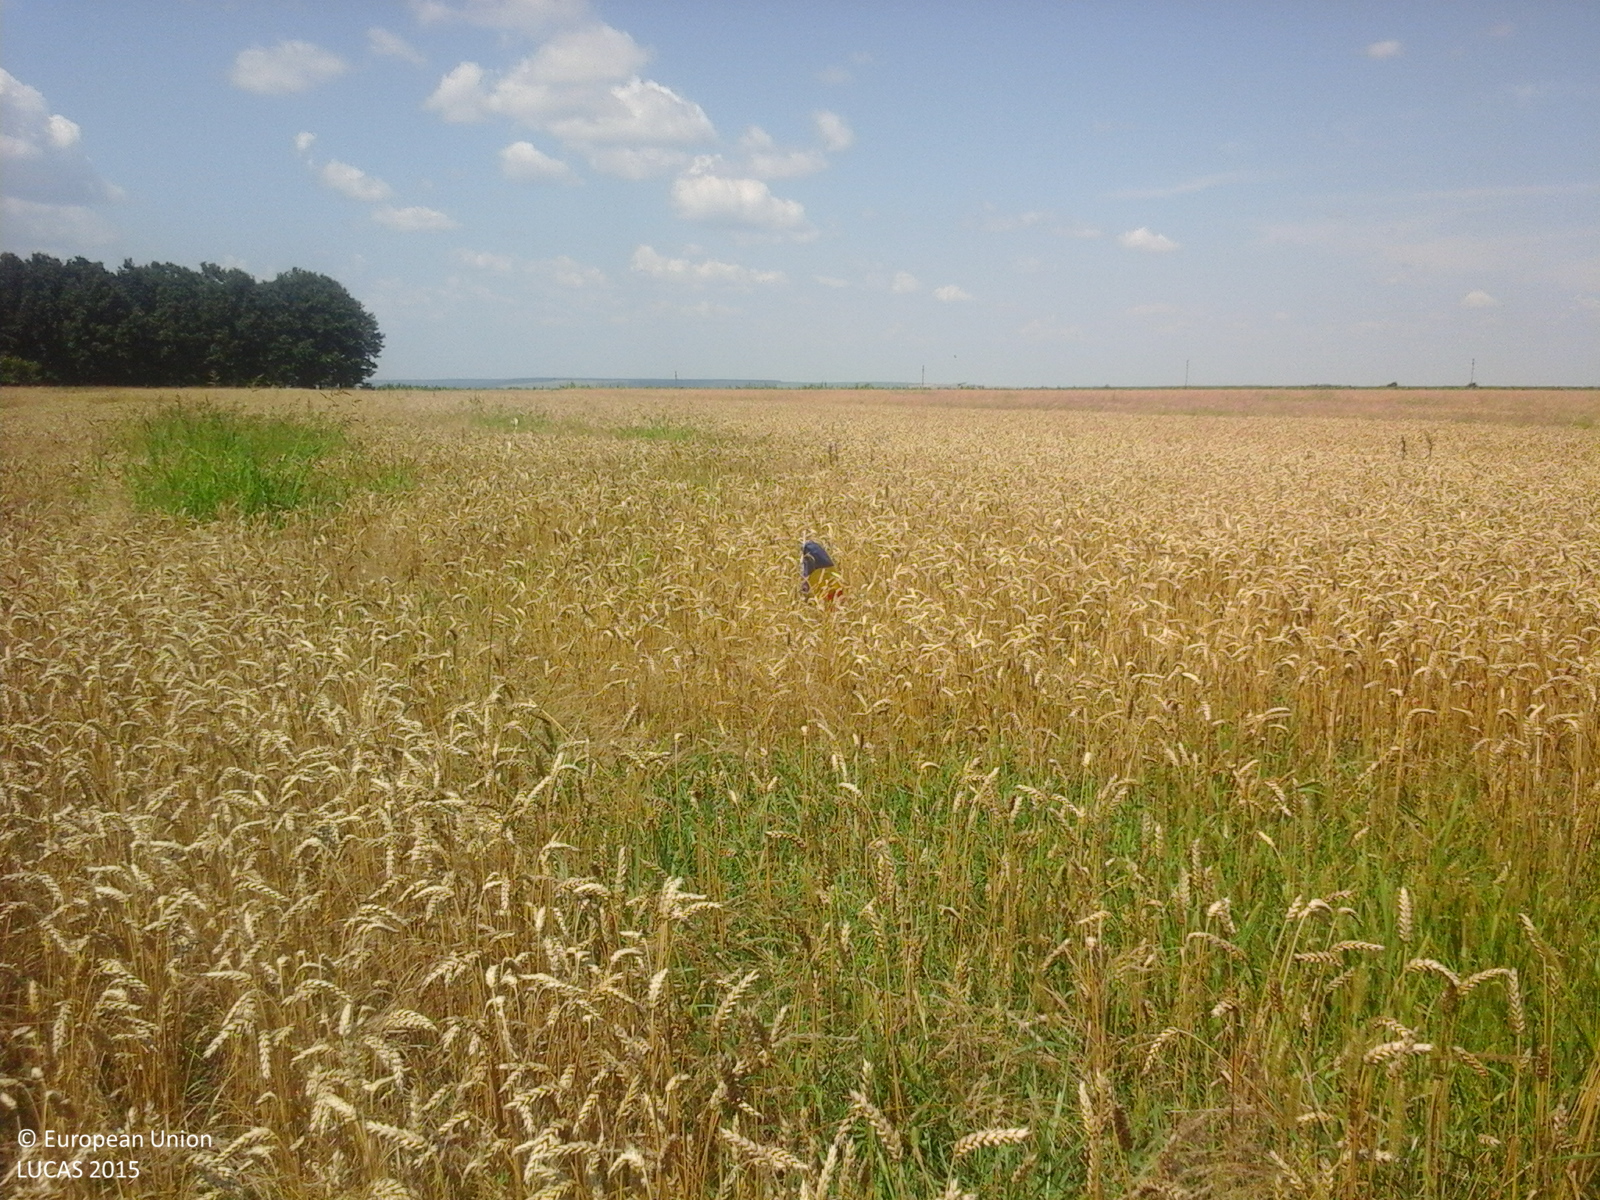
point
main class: Cropland
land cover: Common wheat
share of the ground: > 75 %
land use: Agriculture (excluding fallow land and kitchen gardens)
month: July
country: RO
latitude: 44.2670
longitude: 24.1812
